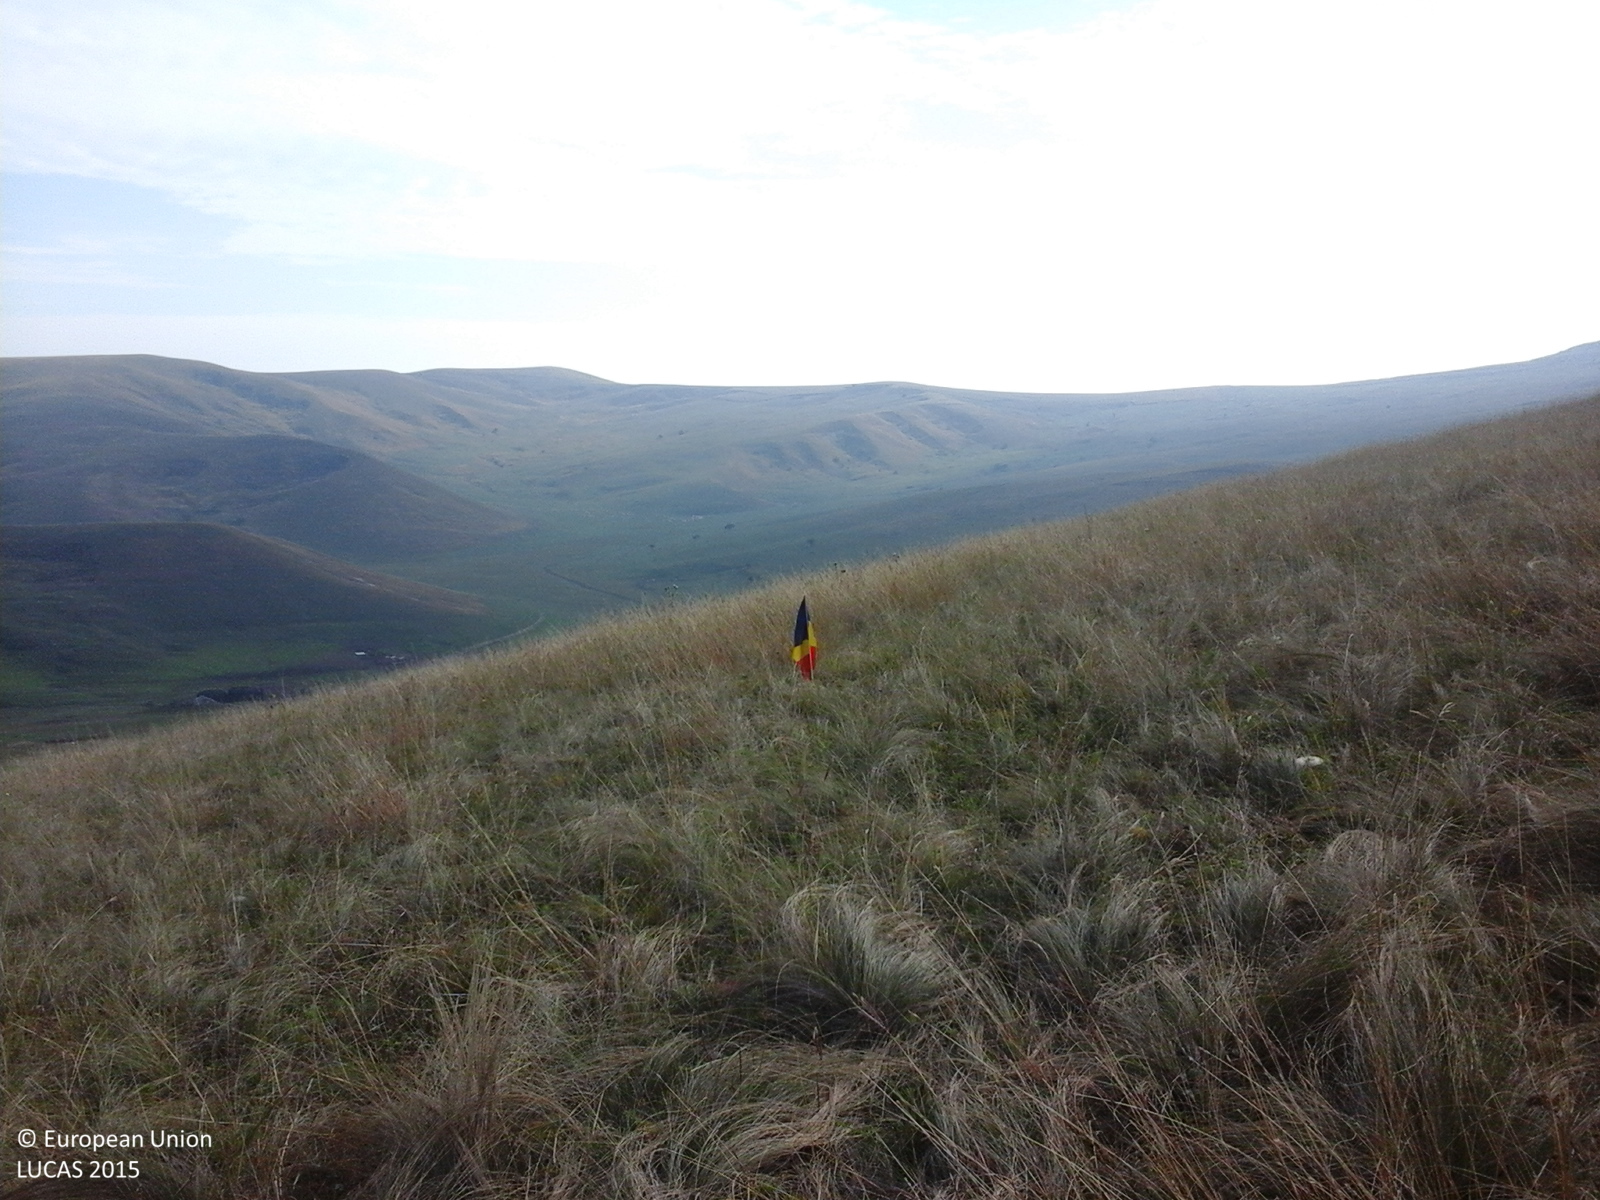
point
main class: Grassland
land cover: Grassland without tree/shrub cover
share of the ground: > 75 %
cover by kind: herbaceous plants 100 %
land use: Agriculture (excluding fallow land and kitchen gardens)
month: October
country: RO
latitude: 46.4548
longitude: 23.8085
